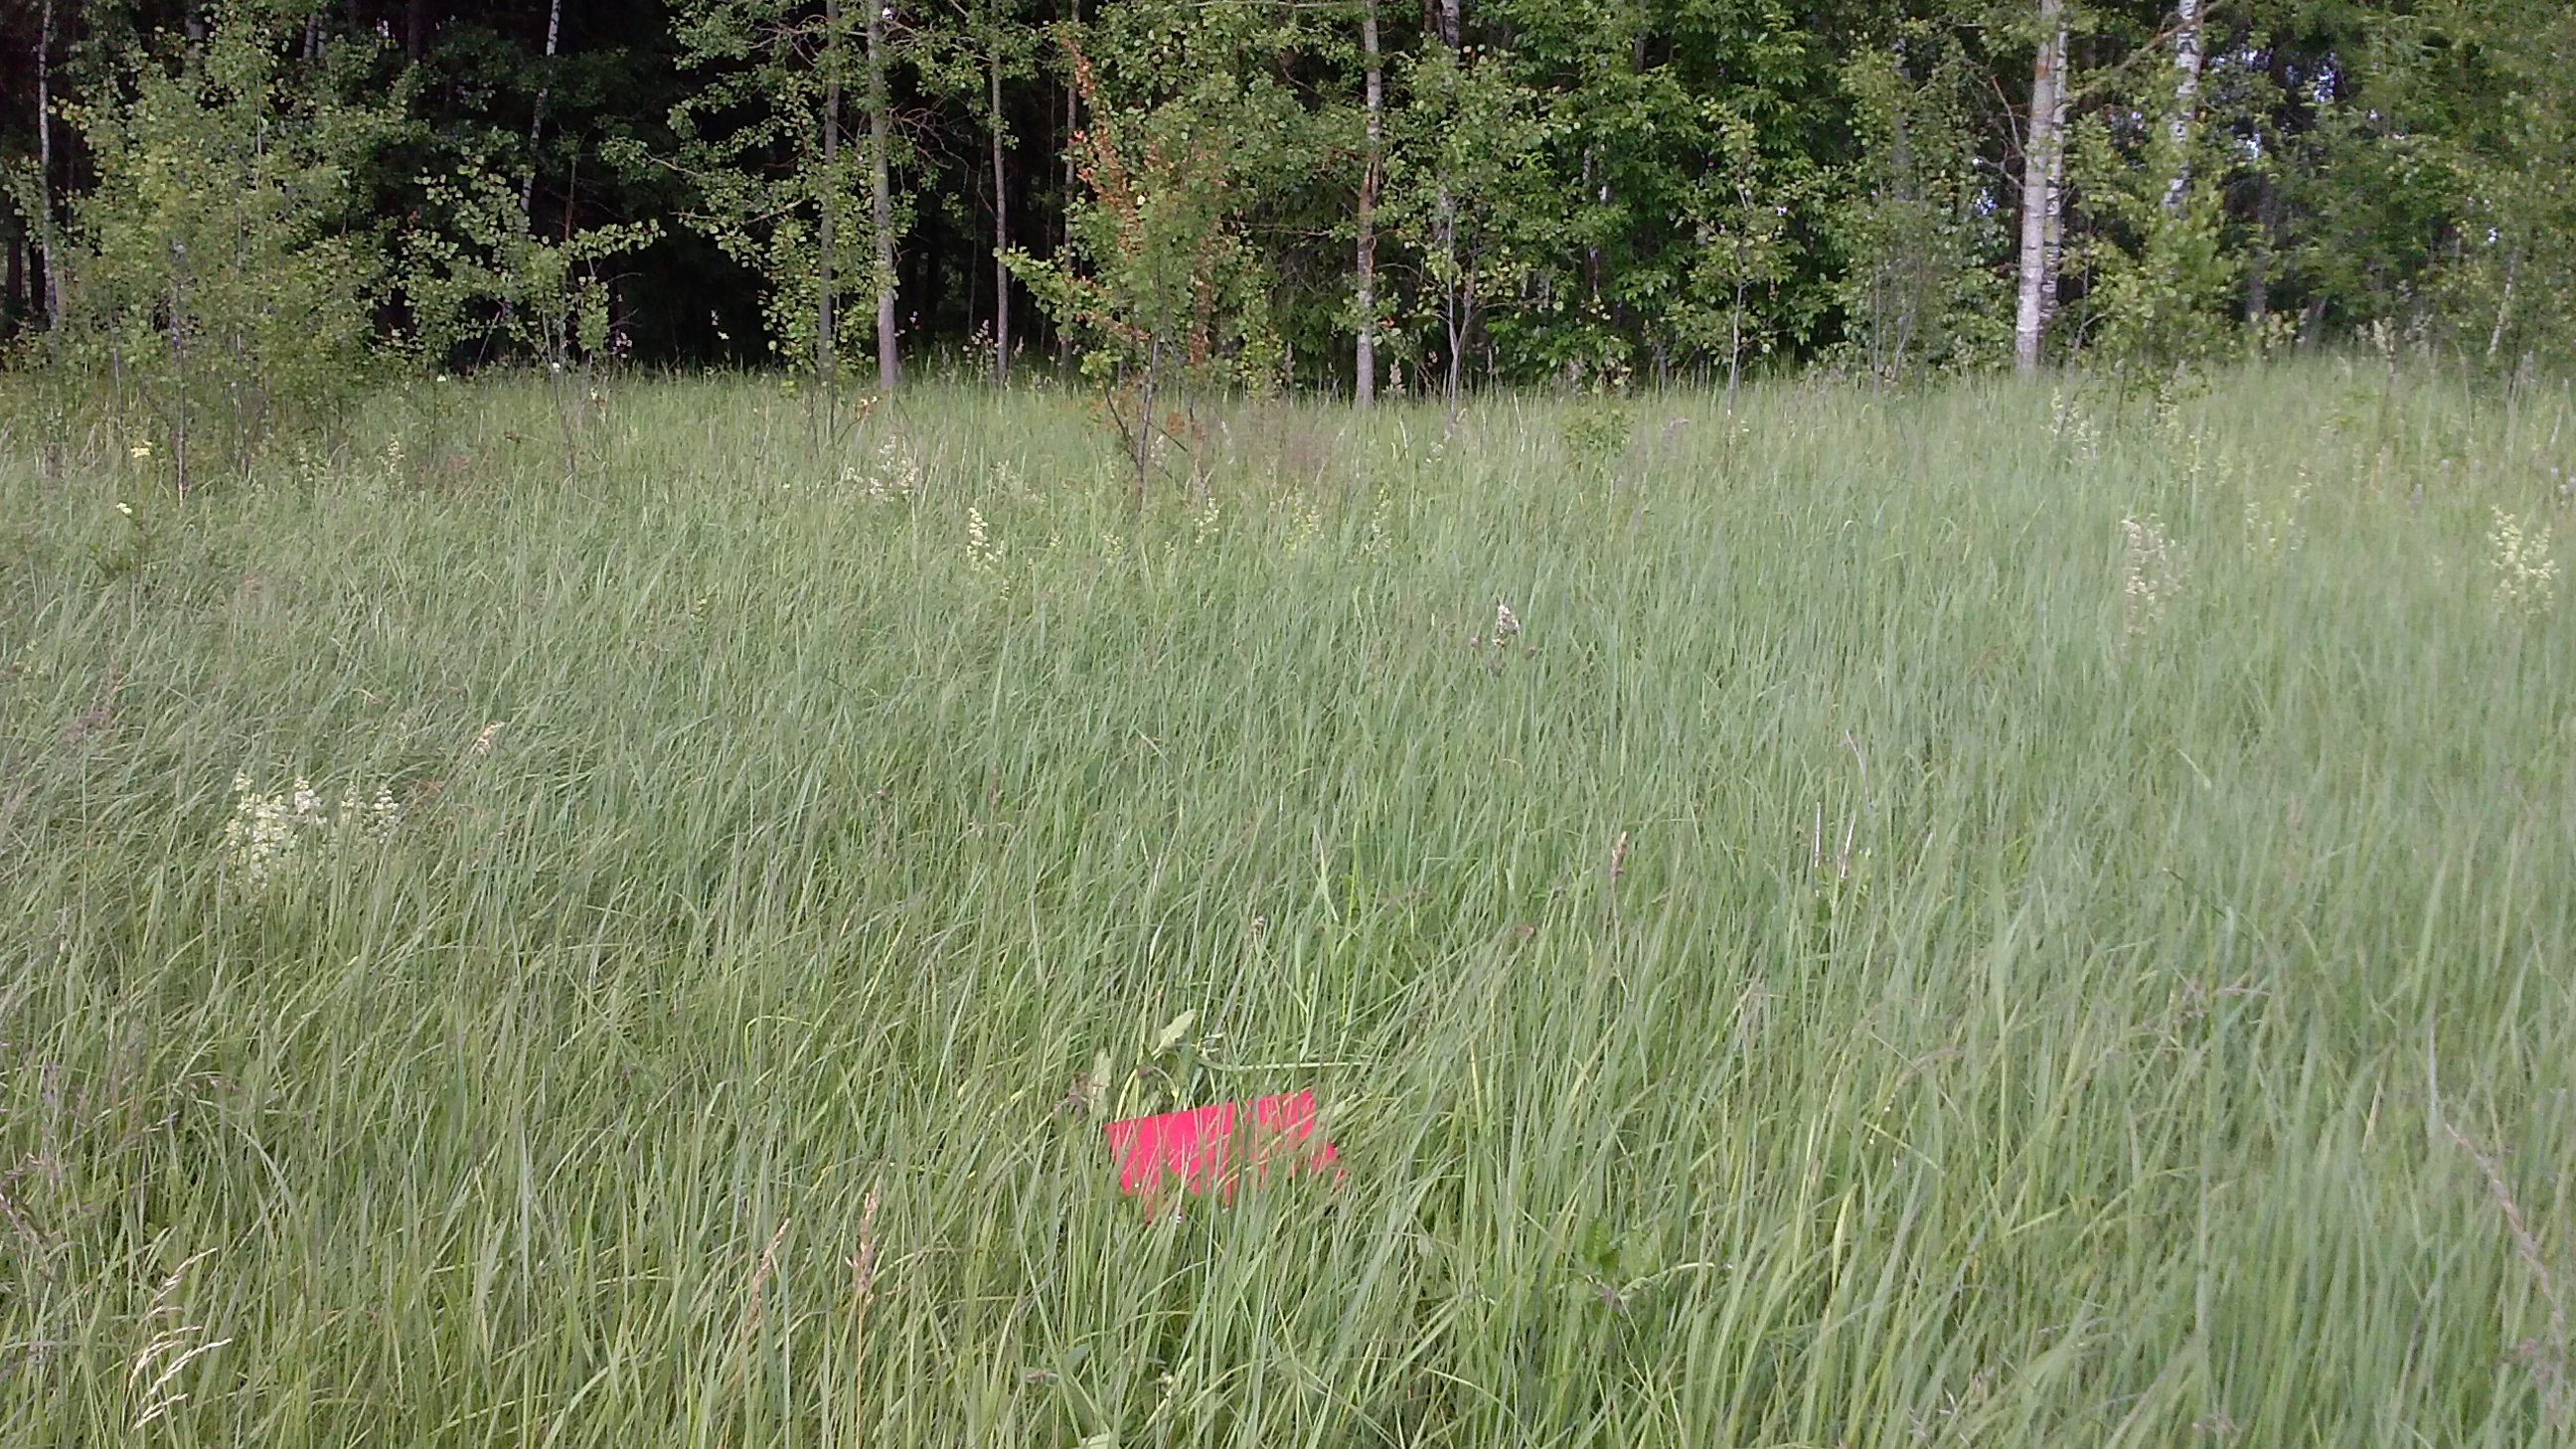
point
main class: Grassland
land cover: Grassland without tree/shrub cover
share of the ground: > 75 %
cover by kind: herbaceous plants 100 %
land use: Agriculture (excluding fallow land and kitchen gardens)
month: June
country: LV
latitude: 56.4825
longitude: 27.9088
